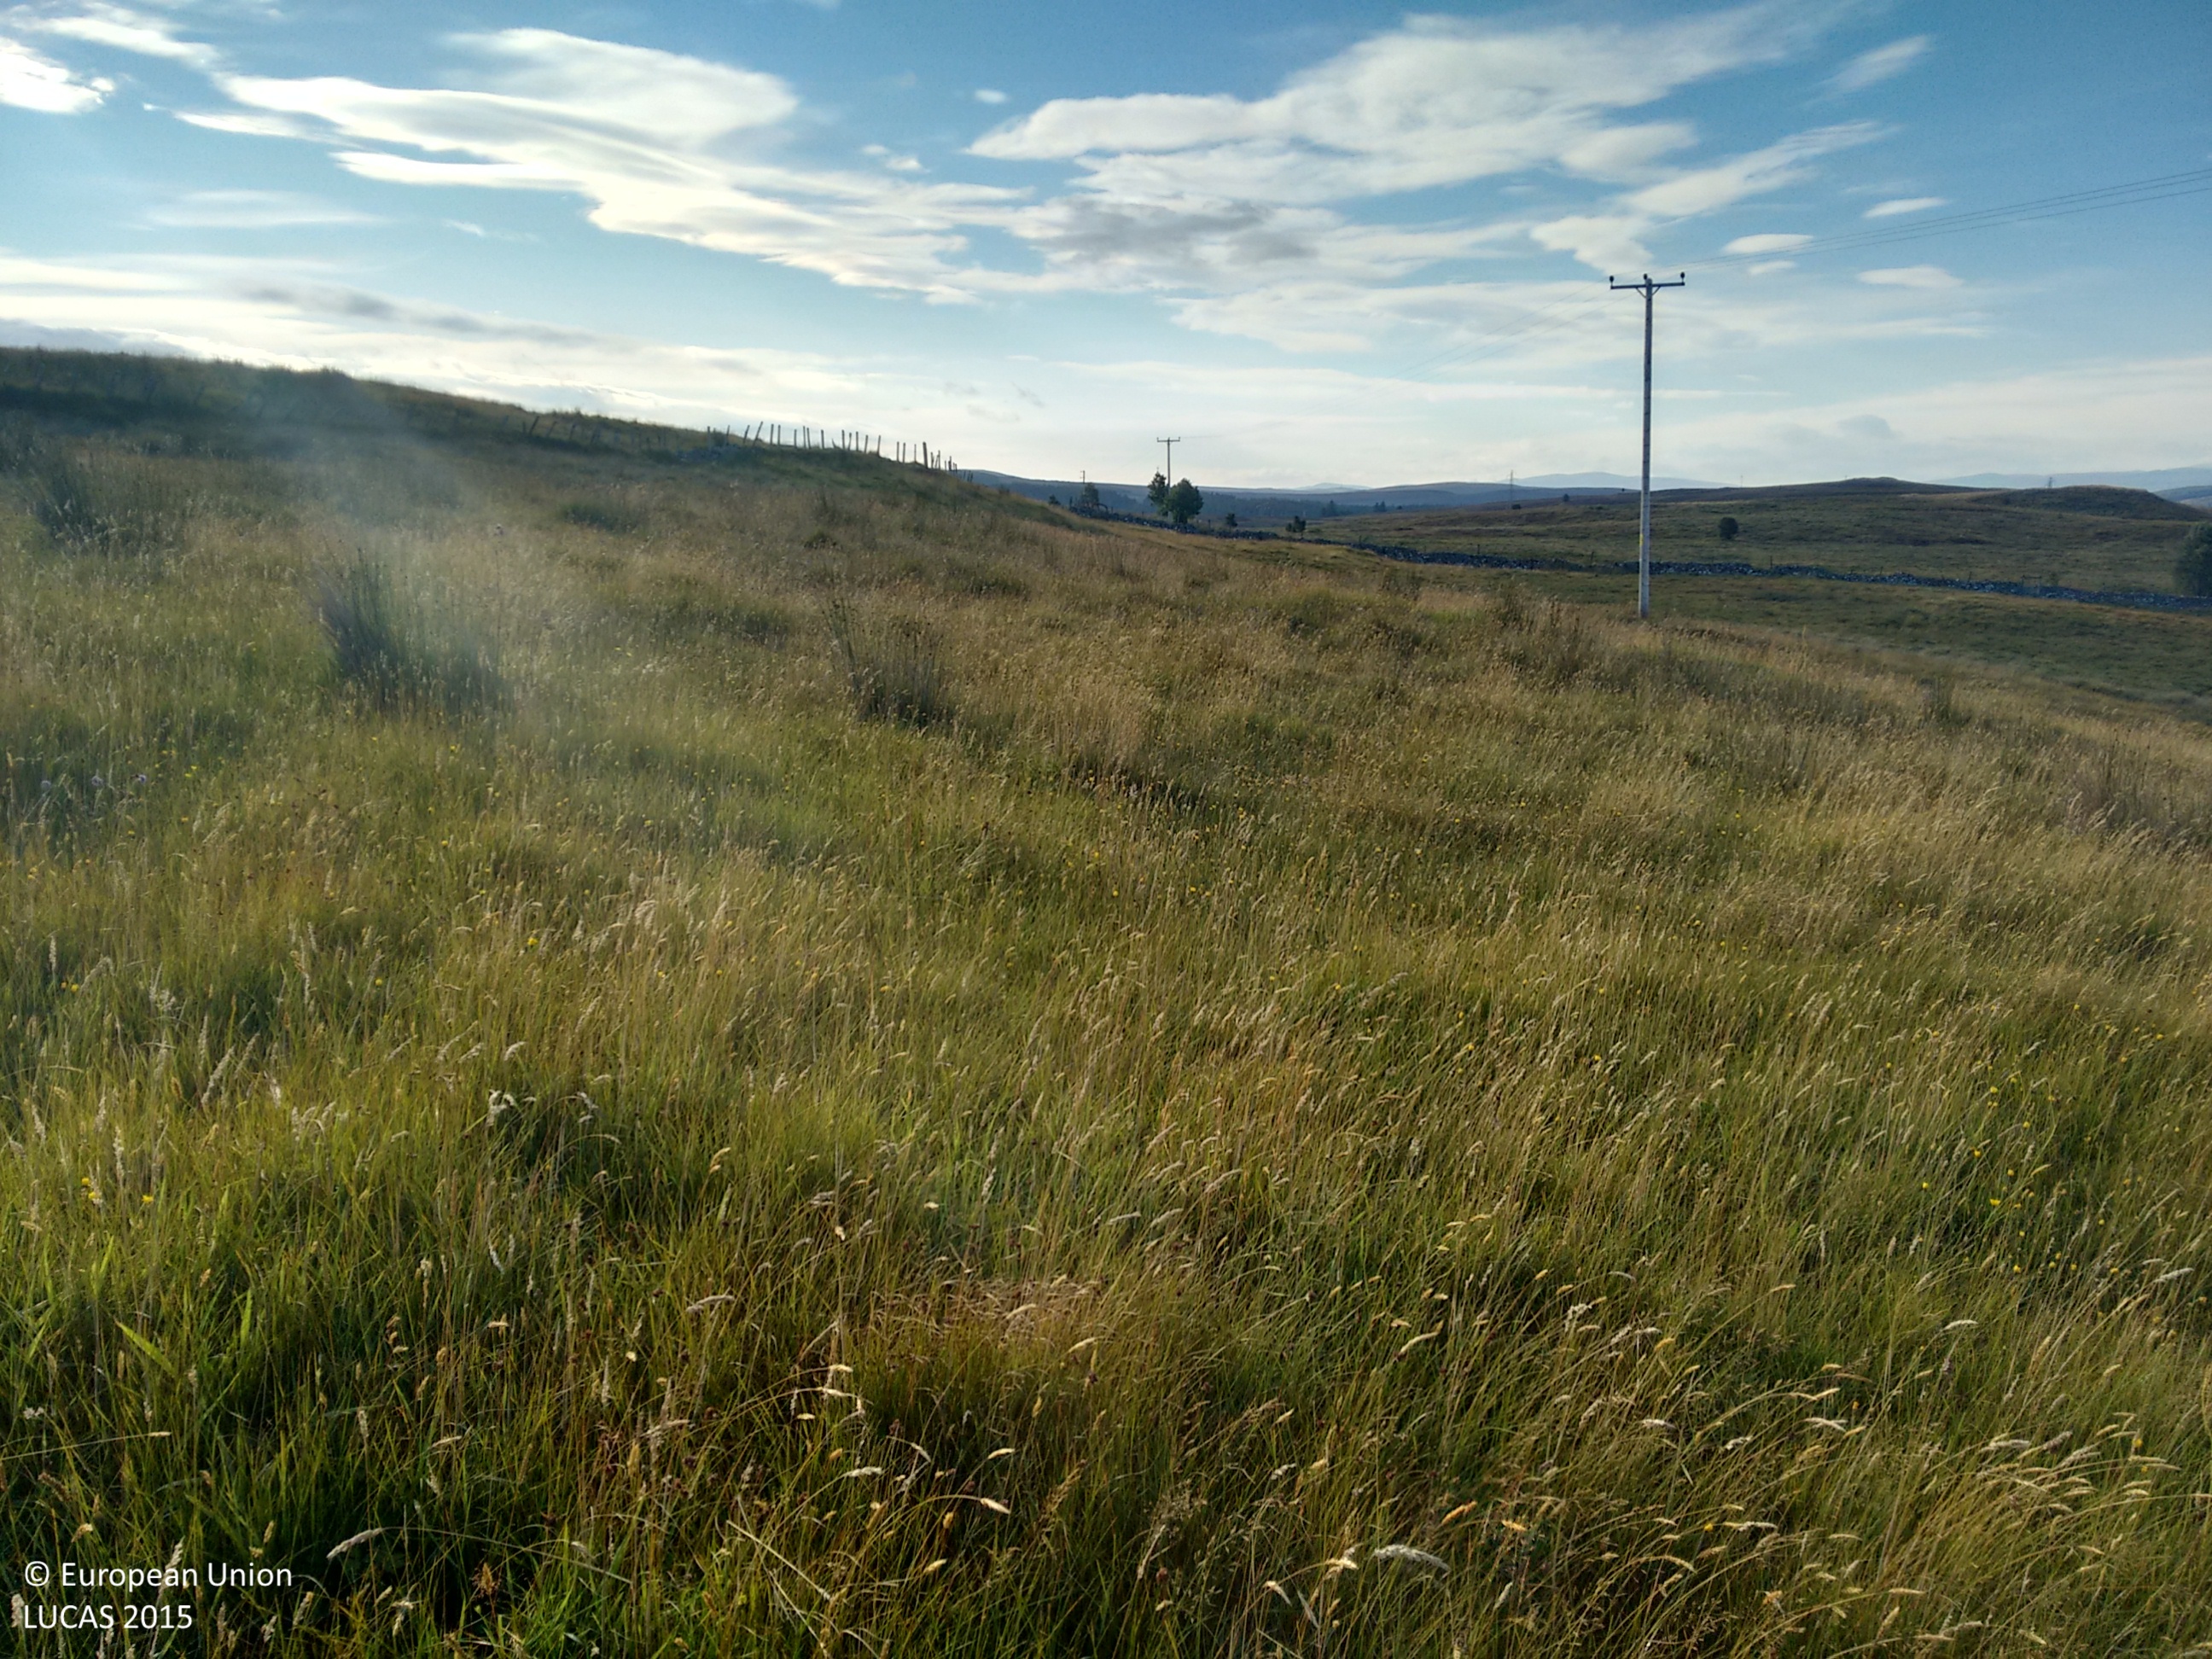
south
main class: Grassland
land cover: Grassland without tree/shrub cover
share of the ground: > 75 %
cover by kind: herbaceous plants 100 %
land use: Agriculture (excluding fallow land and kitchen gardens)
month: September
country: GB
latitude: 58.0428
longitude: -4.3996
